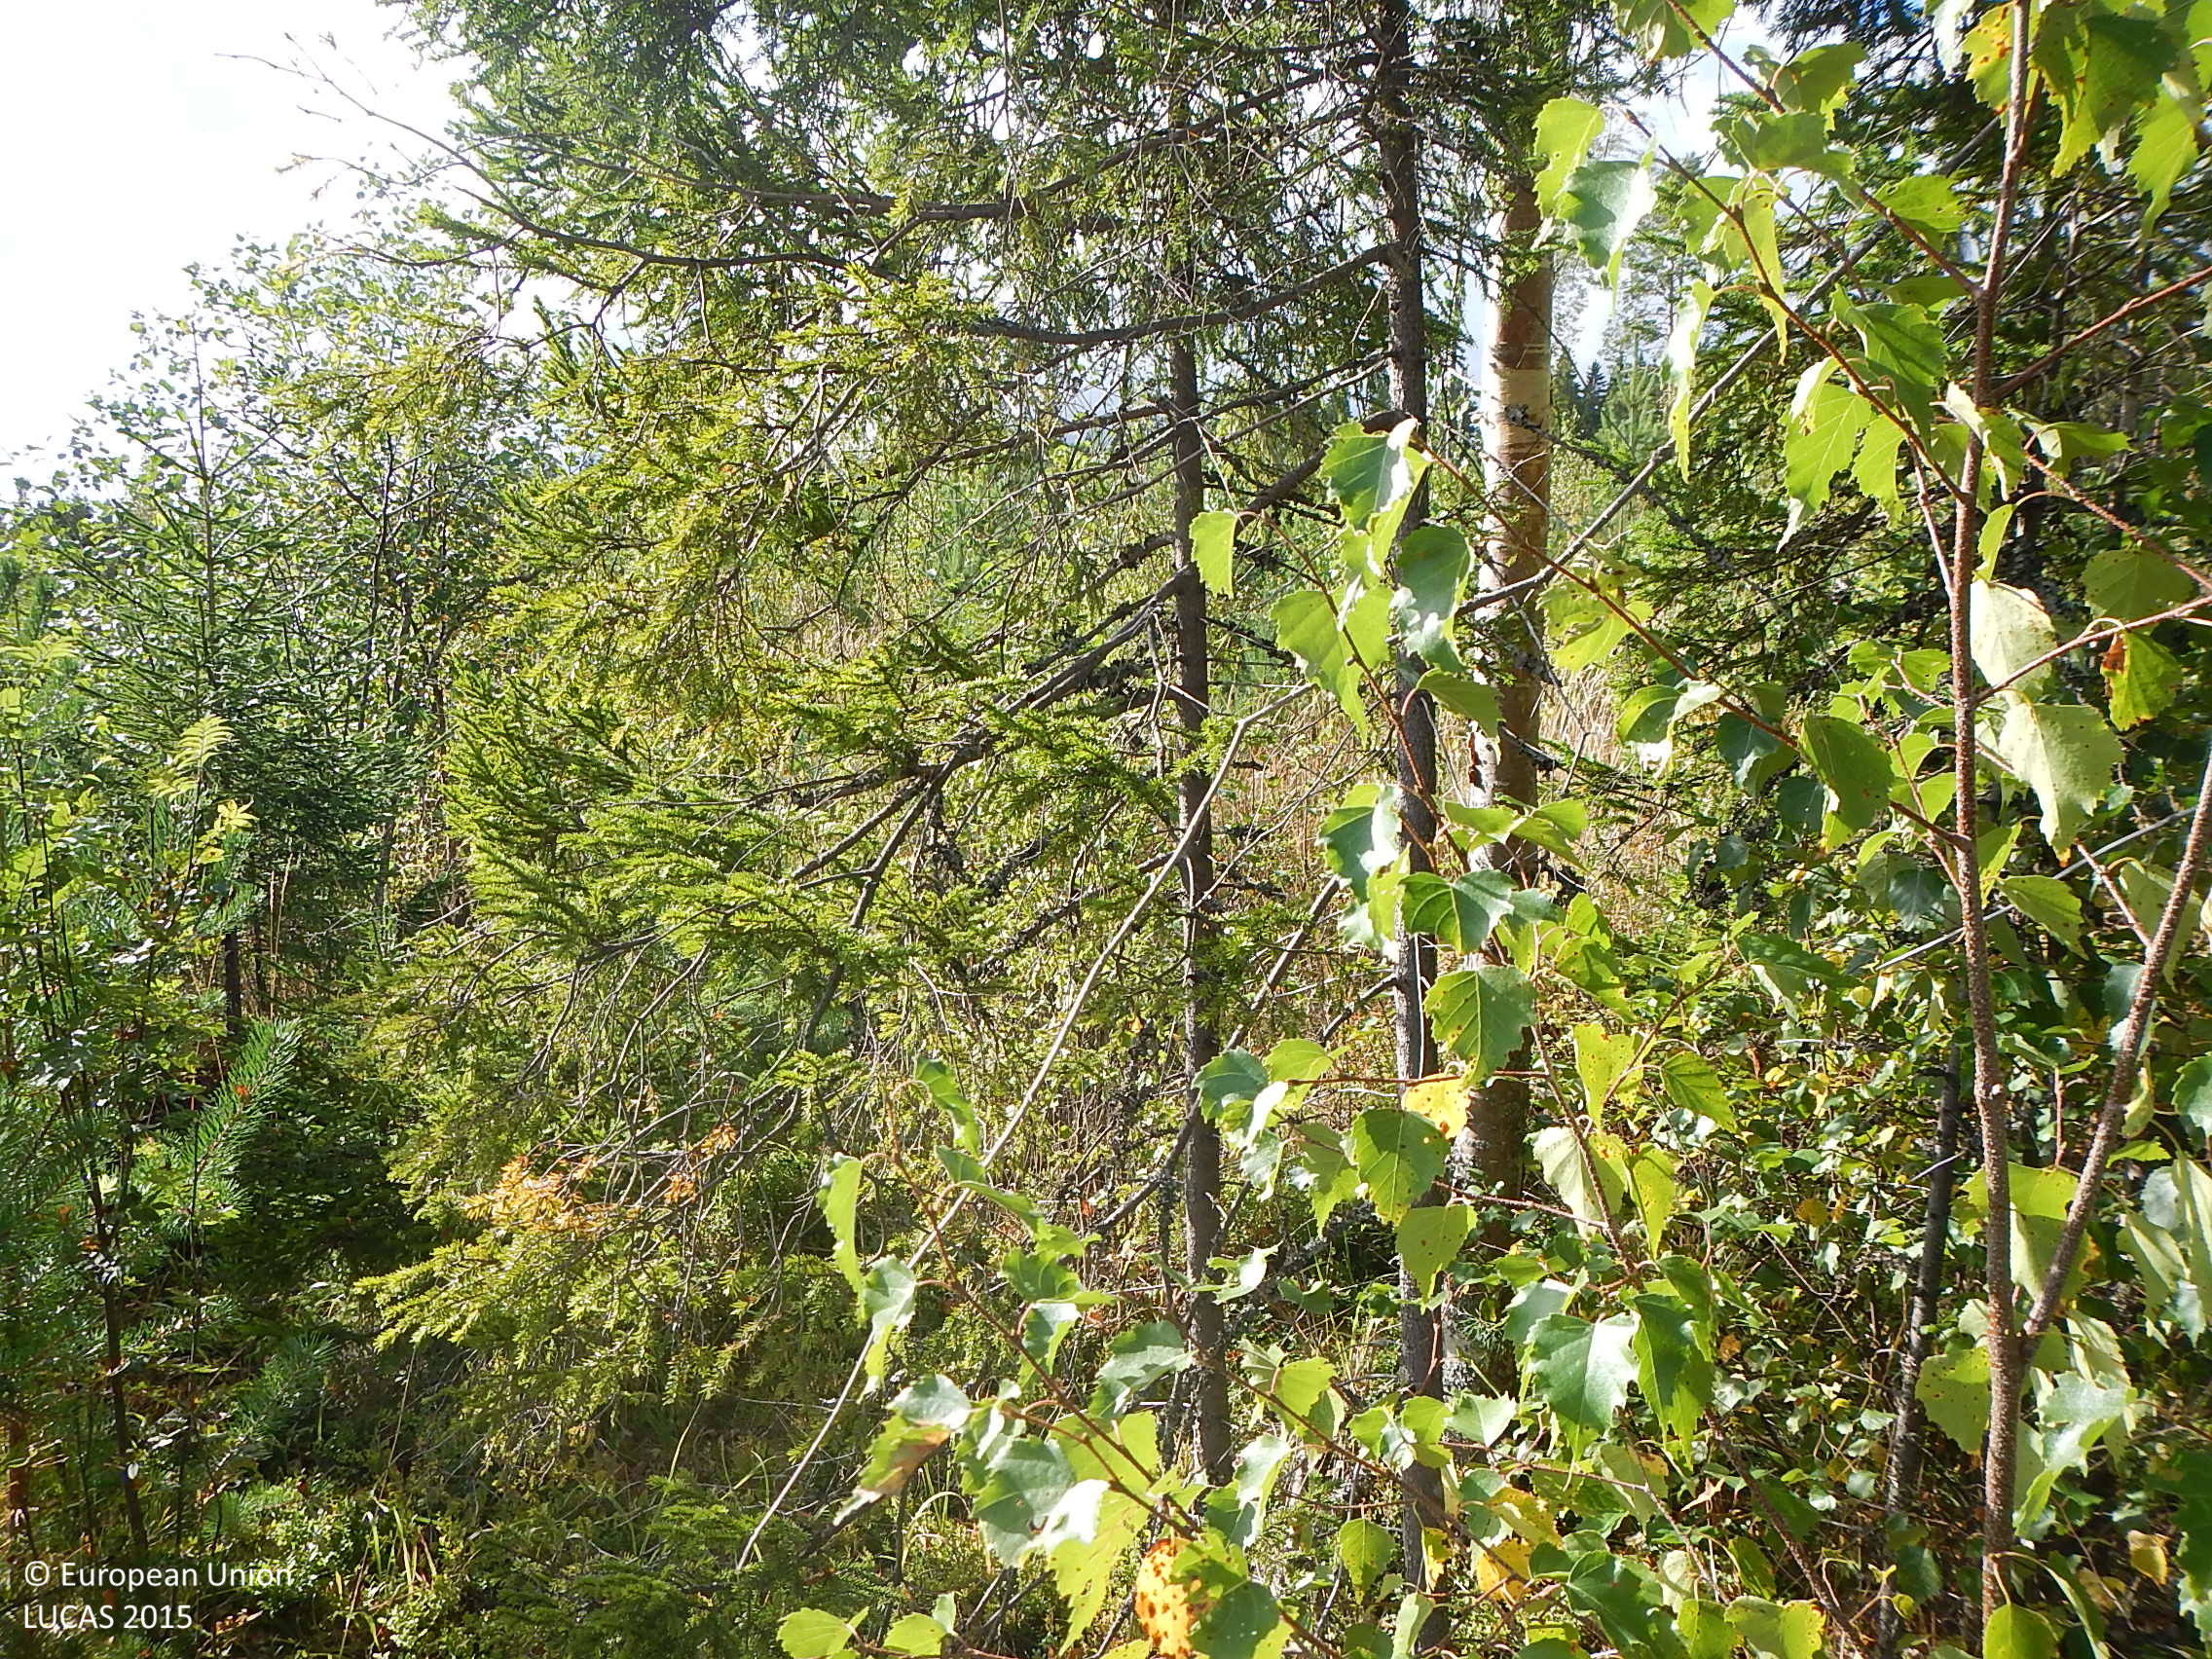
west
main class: Woodland
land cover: Other mixed woodland
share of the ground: 50 - 75 %
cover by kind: coniferous forest trees 25 %, broadleaved forest trees 25 %, shrubs 25 %, herbaceous plants 20 %, lichens and mosses 5 %
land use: Forestry
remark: Nursery
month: September
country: FI
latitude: 61.5072
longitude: 22.0268
